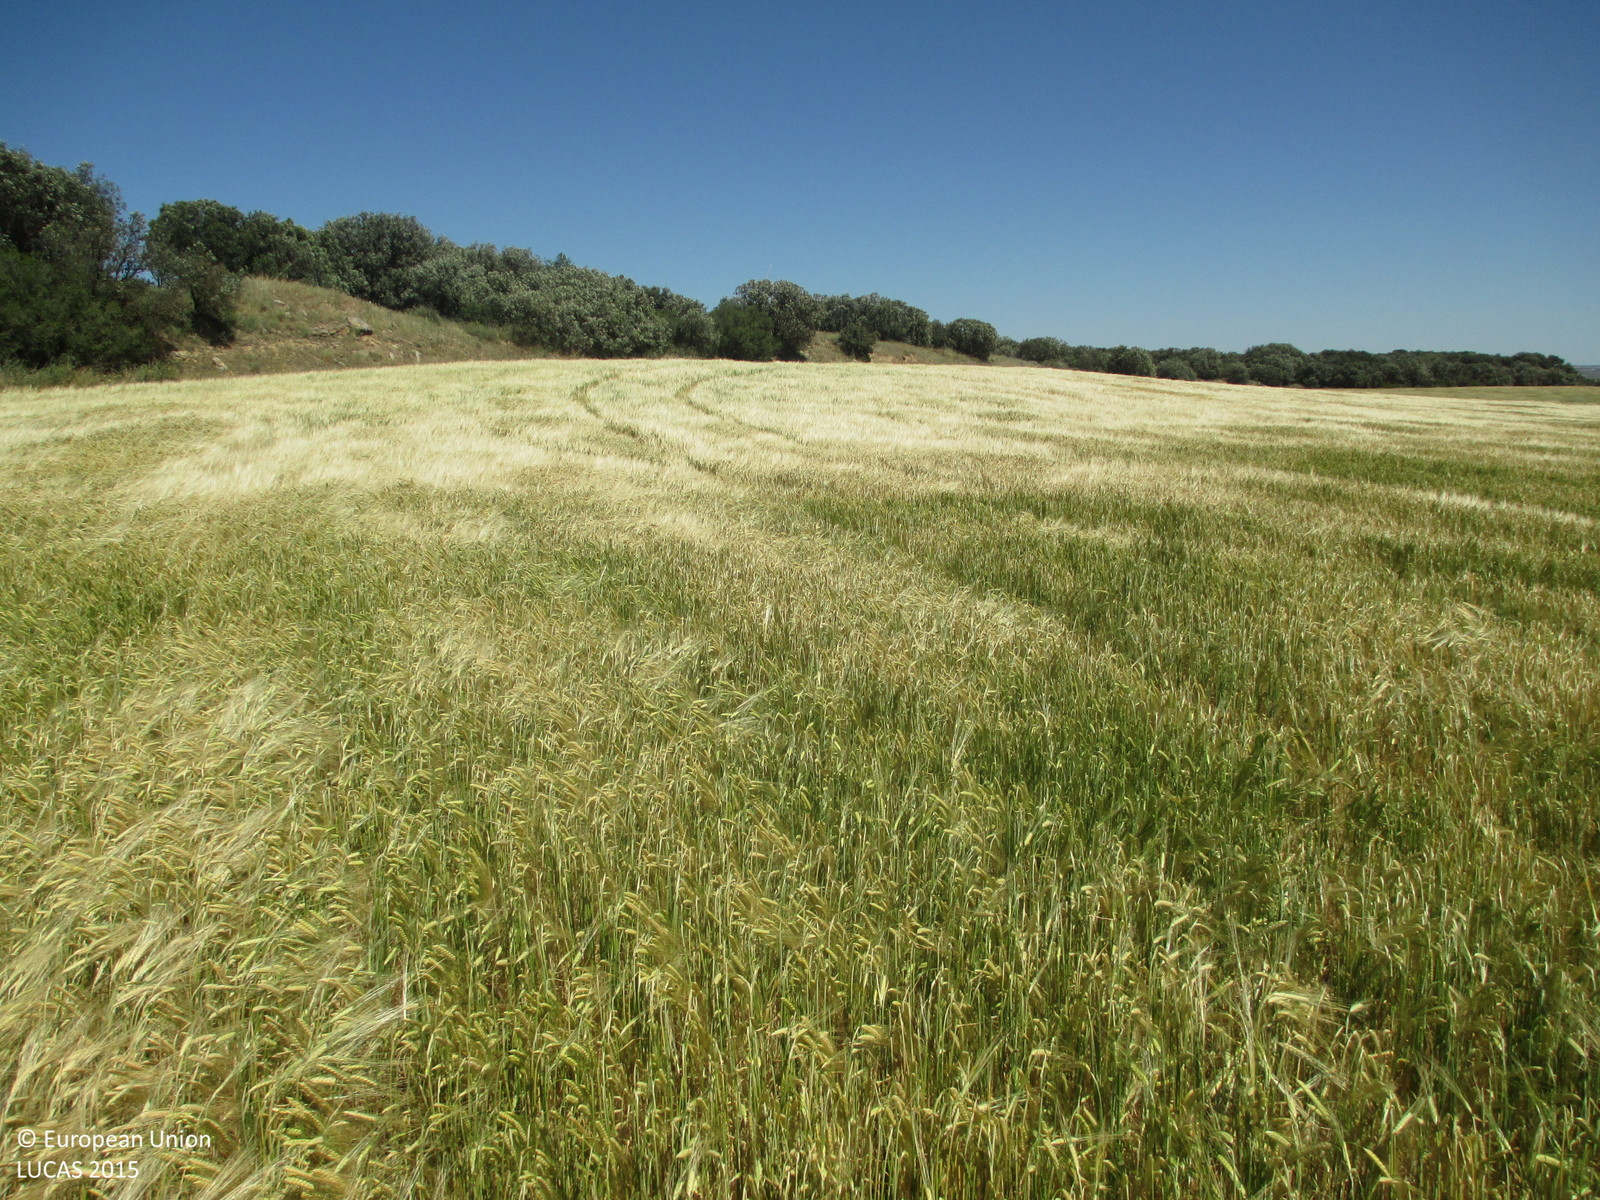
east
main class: Cropland
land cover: Barley
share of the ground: > 75 %
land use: Agriculture (excluding fallow land and kitchen gardens)
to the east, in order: Barley; Broadleaved woodland; Spontaneously vegetated surfaces; Grass margins; Common wheat
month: May
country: ES
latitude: 42.0284
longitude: -0.2021
